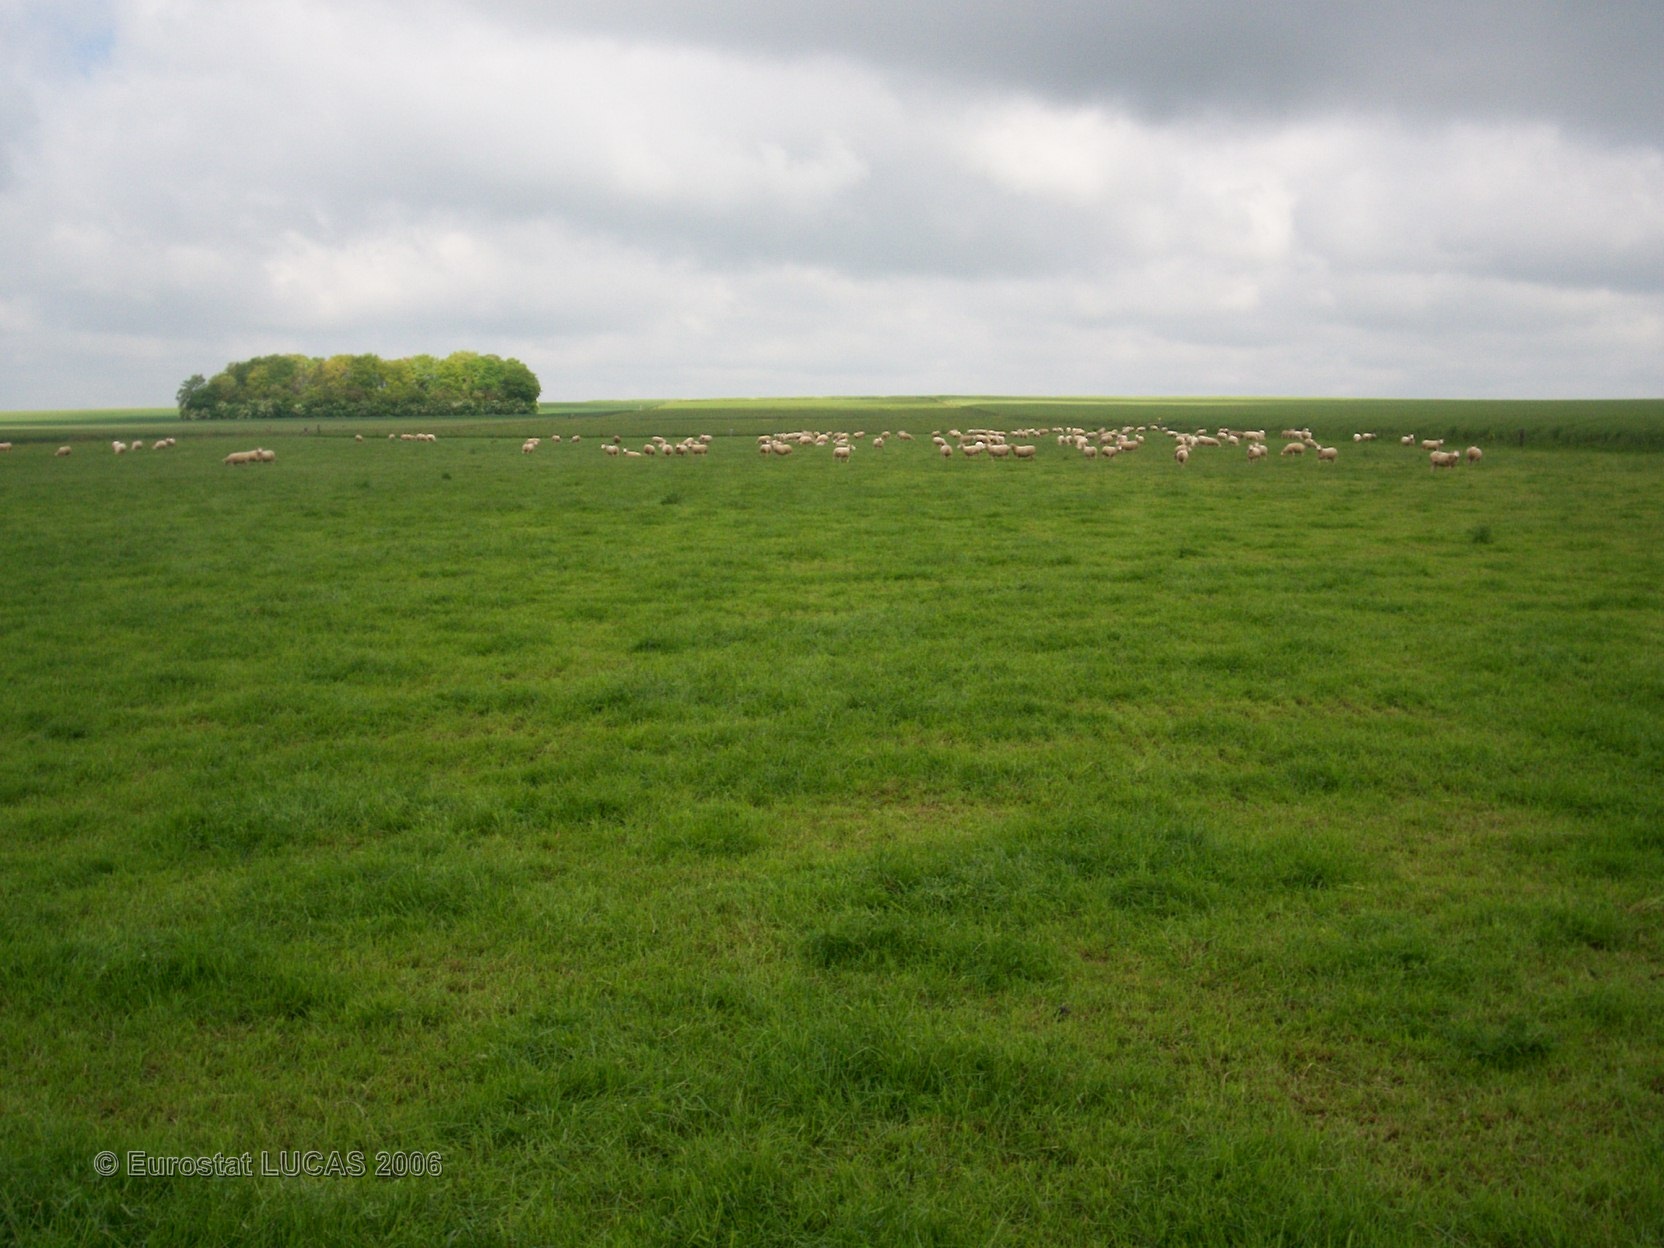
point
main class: Grassland
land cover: Grassland without tree/shrub cover
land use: Agriculture (excluding fallow land and kitchen gardens)
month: June
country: FR
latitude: 48.5530
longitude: 4.4560
